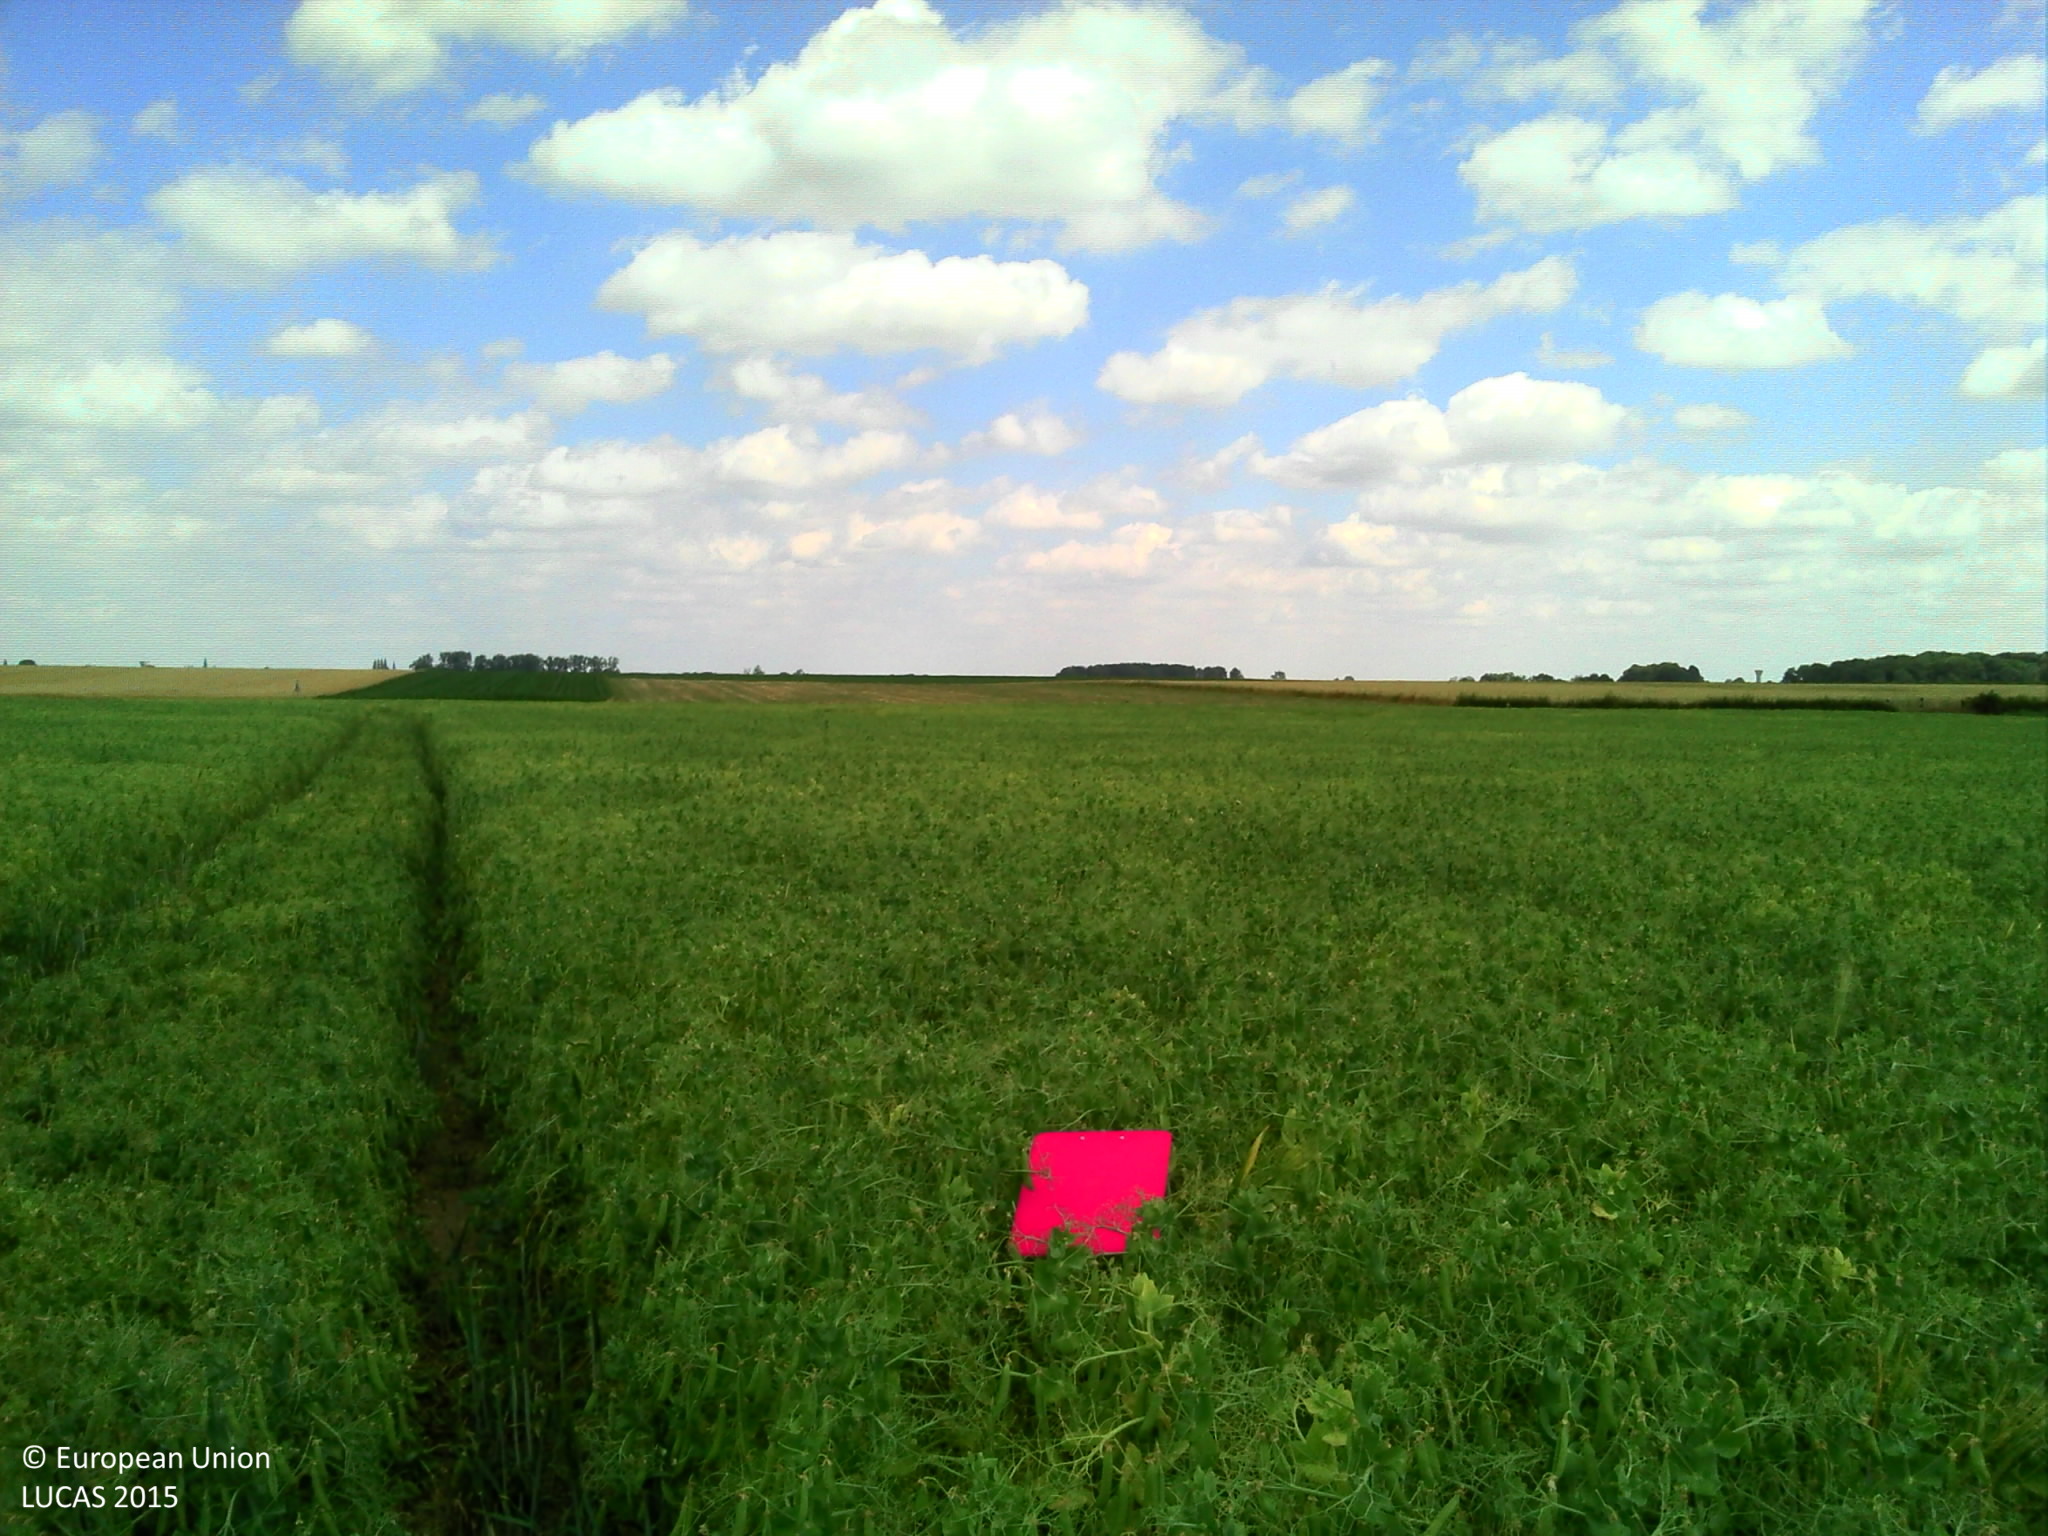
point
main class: Cropland
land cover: Dry pulses
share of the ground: > 75 %
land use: Agriculture (excluding fallow land and kitchen gardens)
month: July
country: FR
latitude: 49.6513
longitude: 1.7697
